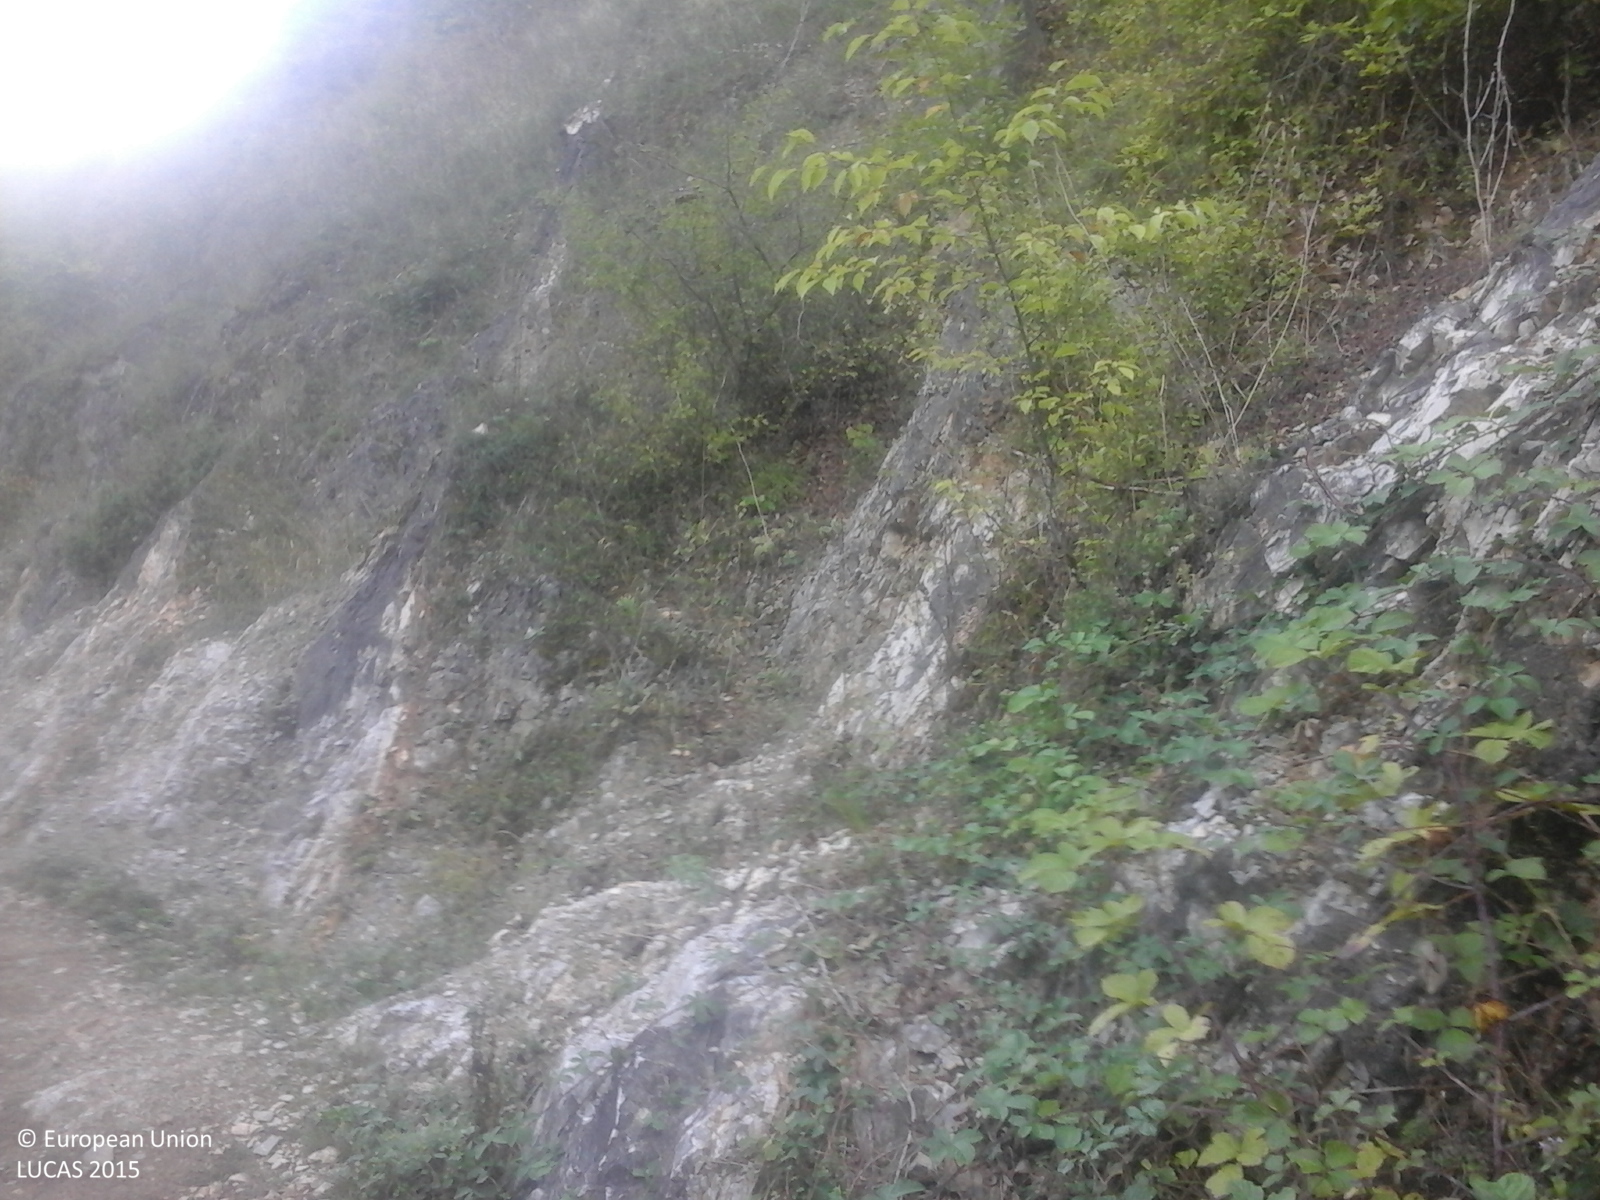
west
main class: Grassland
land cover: Grassland with sparse tree/shrub cover
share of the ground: > 75 %
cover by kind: herbaceous plants 85 %, shrubs 10 %, broadleaved forest trees 5 %
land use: Fallow land
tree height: > 5 m
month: September
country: RO
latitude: 45.8397
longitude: 22.4456
